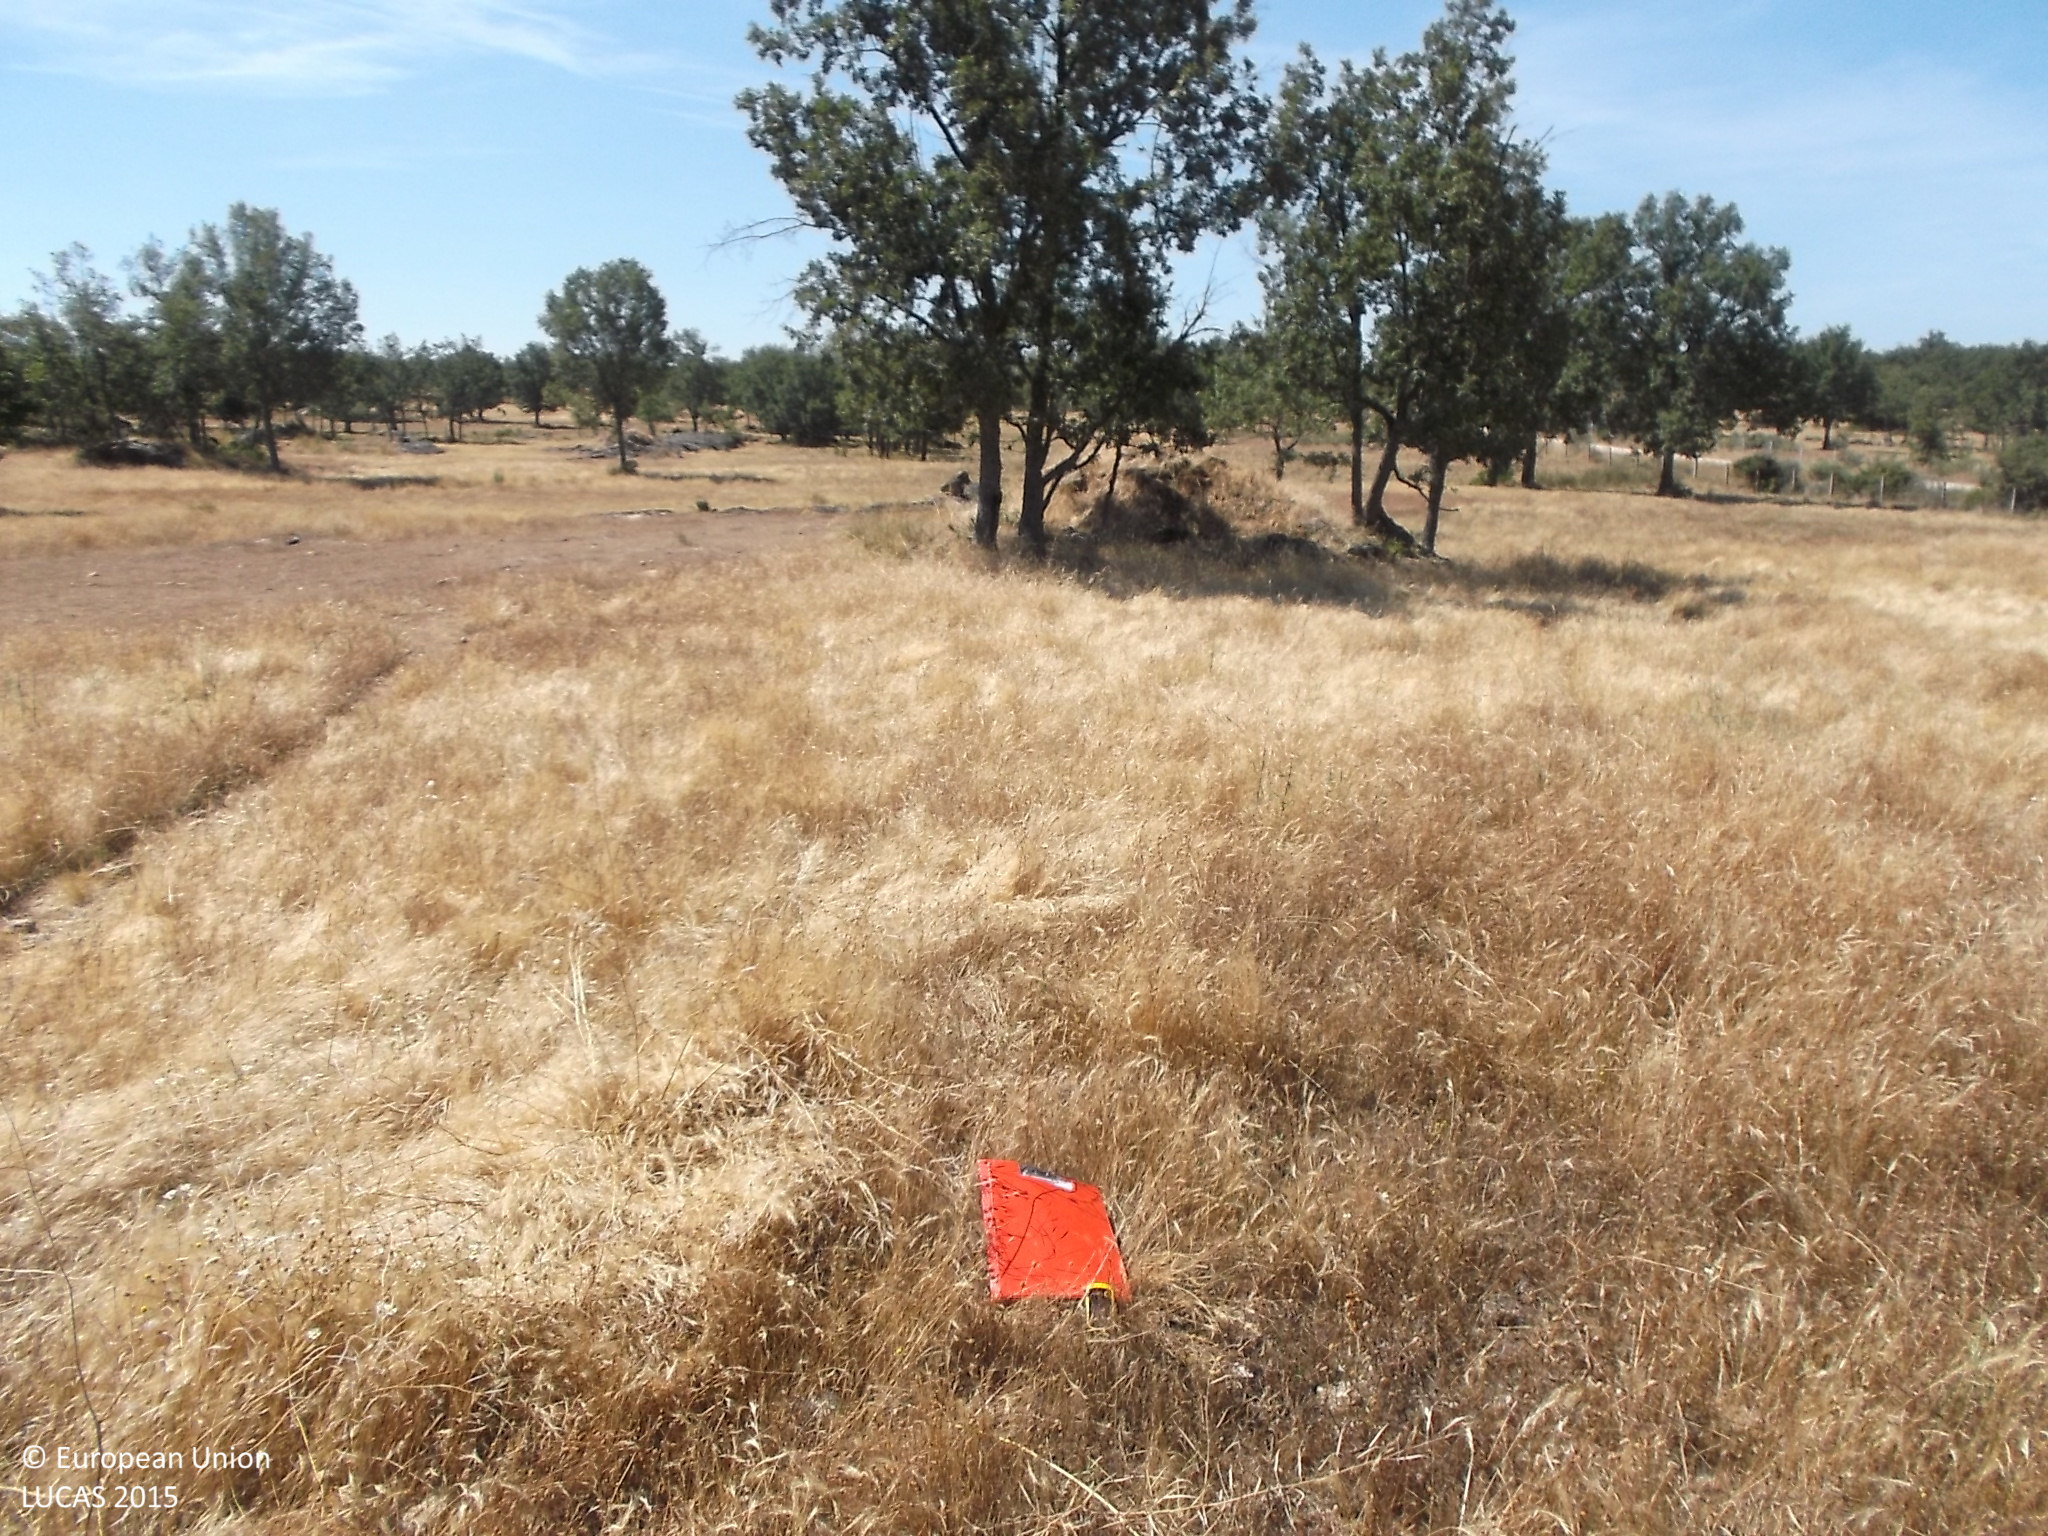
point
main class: Grassland
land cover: Grassland without tree/shrub cover
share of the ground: > 75 %
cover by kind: herbaceous plants 100 %
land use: Agriculture (excluding fallow land and kitchen gardens)
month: July
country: ES
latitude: 41.1851
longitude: -6.4661
